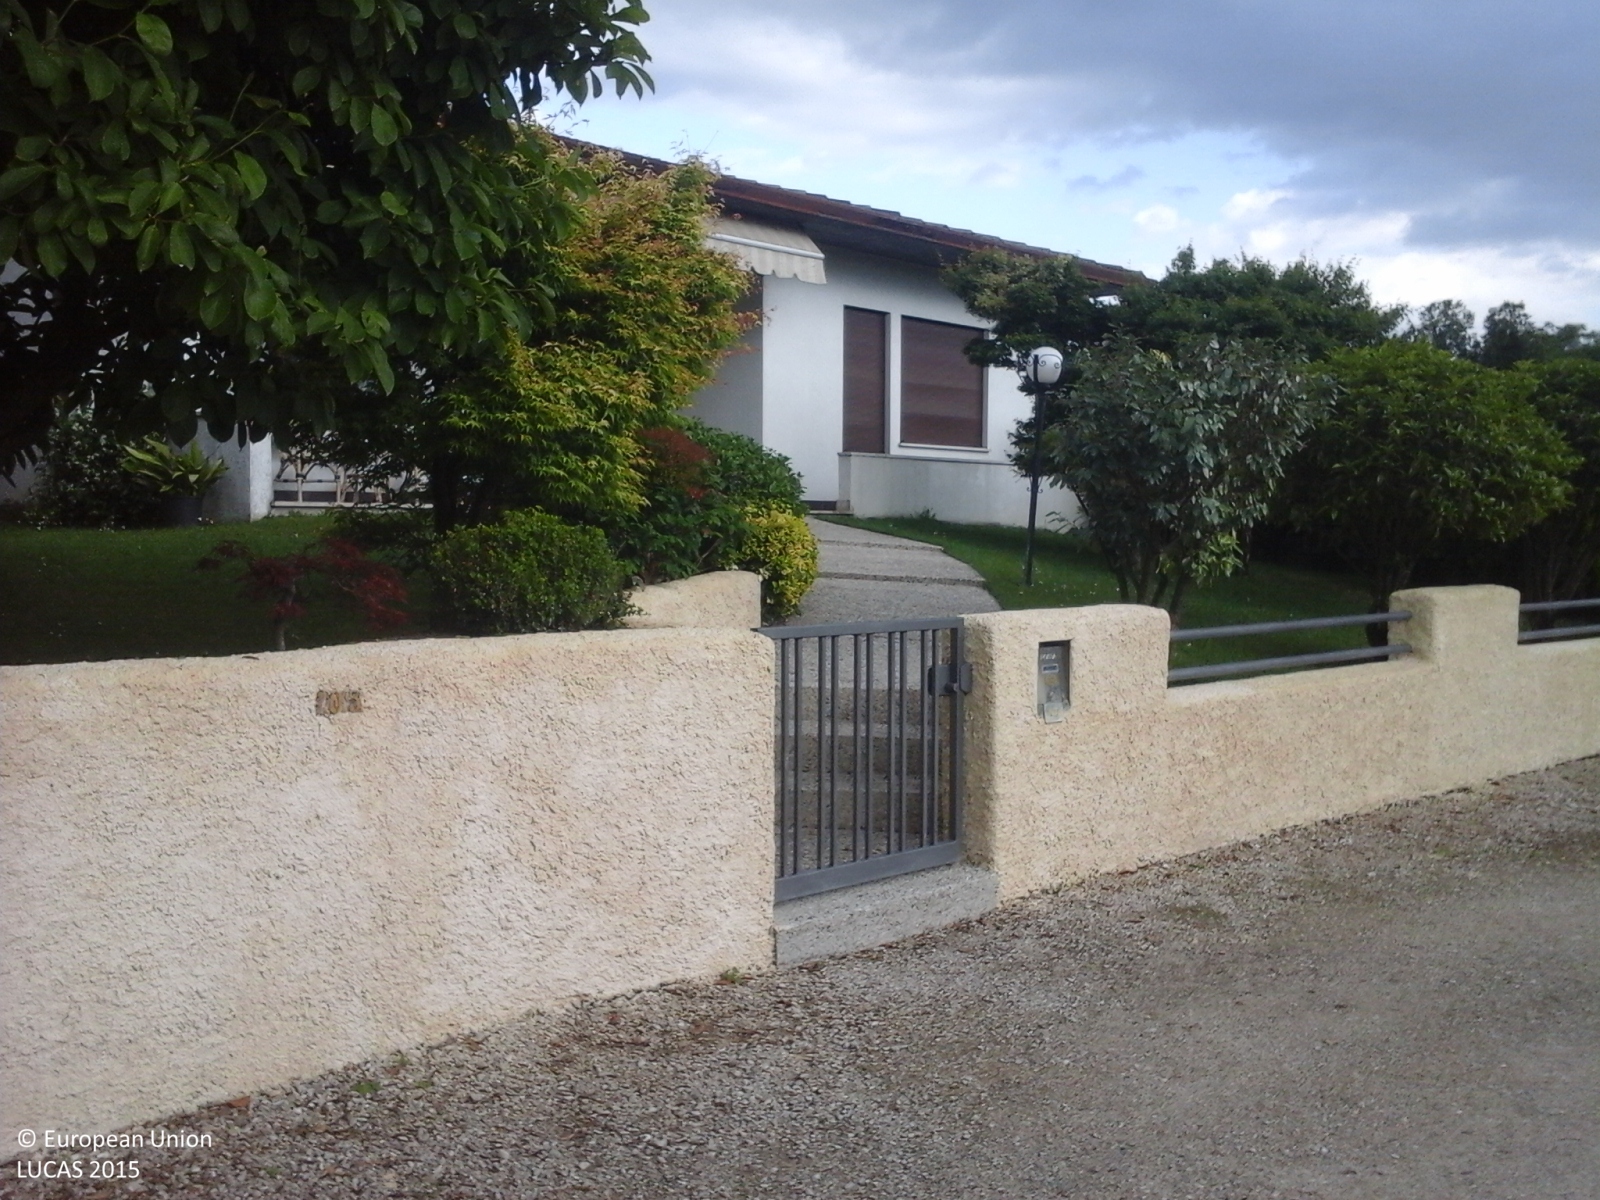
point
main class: Grassland
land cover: Grassland with sparse tree/shrub cover
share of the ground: > 75 %
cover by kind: herbaceous plants 95 %, broadleaved forest trees 5 %
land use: Residential
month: May
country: IT
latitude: 45.7061
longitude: 11.7570
